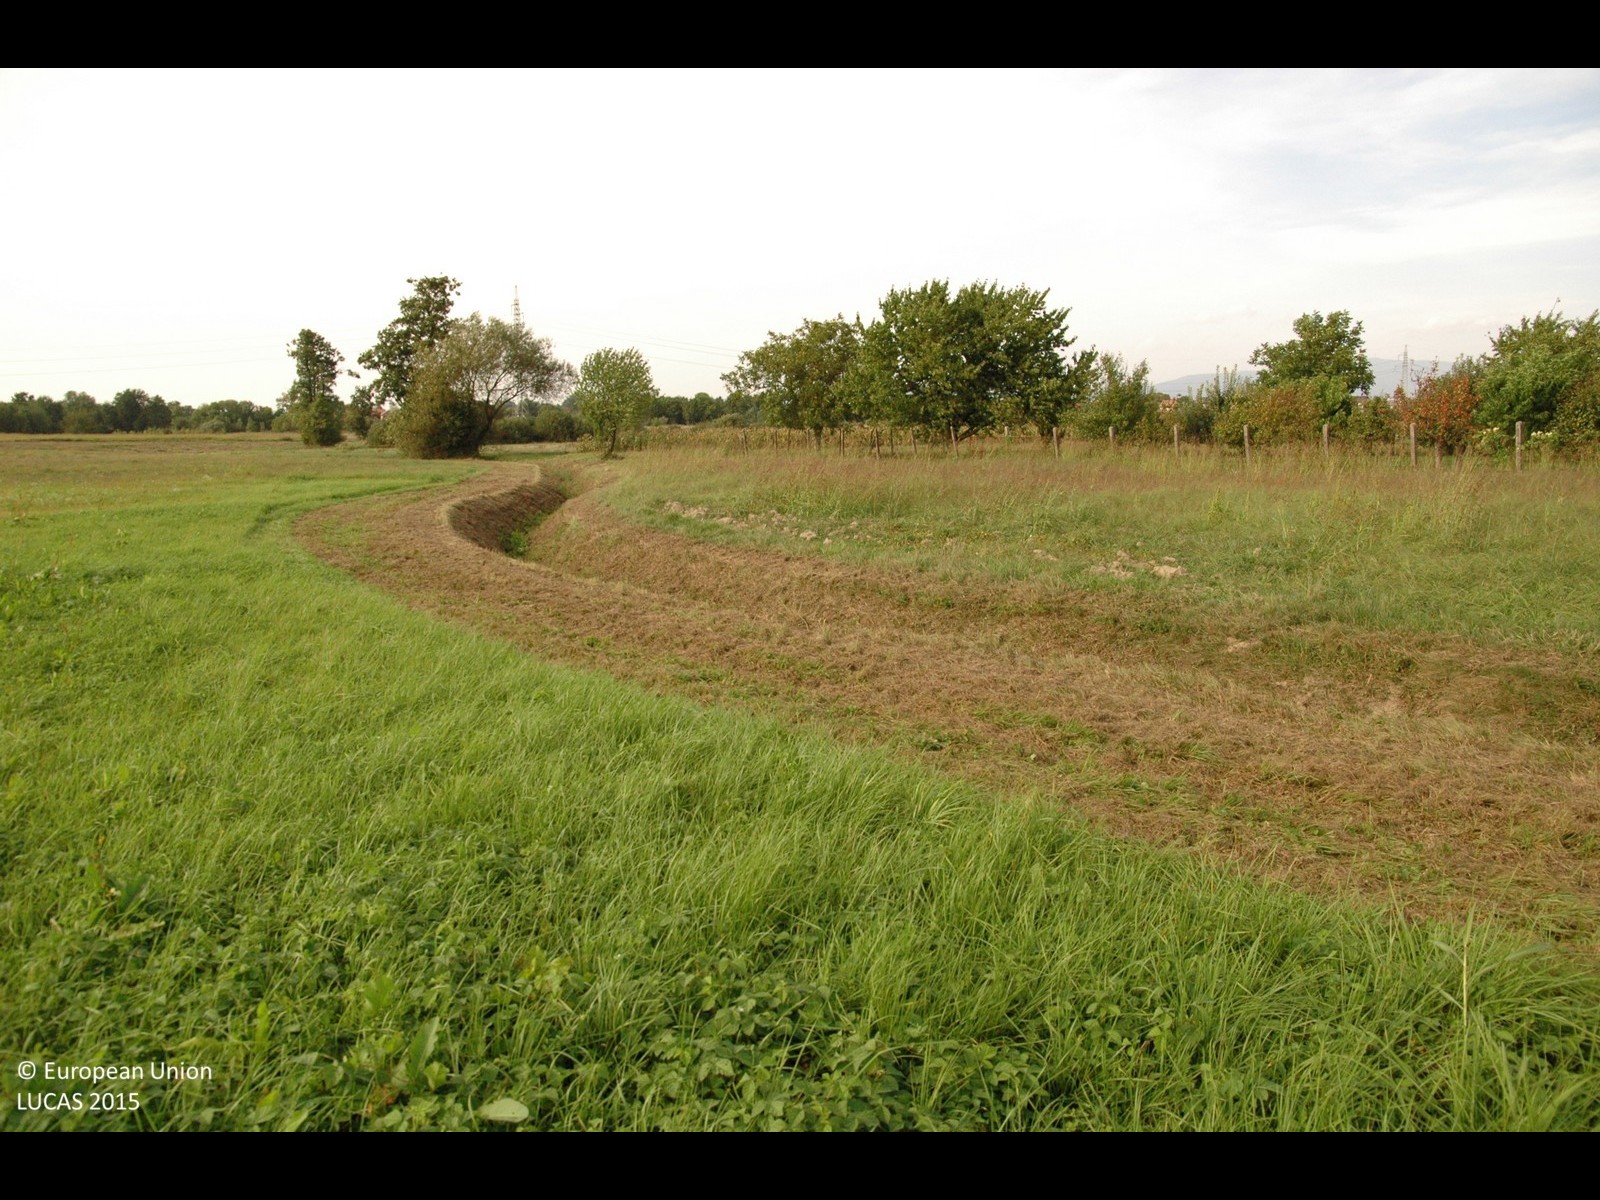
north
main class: Grassland
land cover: Grassland without tree/shrub cover
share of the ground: > 75 %
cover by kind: herbaceous plants 100 %
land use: Agriculture (excluding fallow land and kitchen gardens)
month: September
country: HR
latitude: 45.7176
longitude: 15.9201
